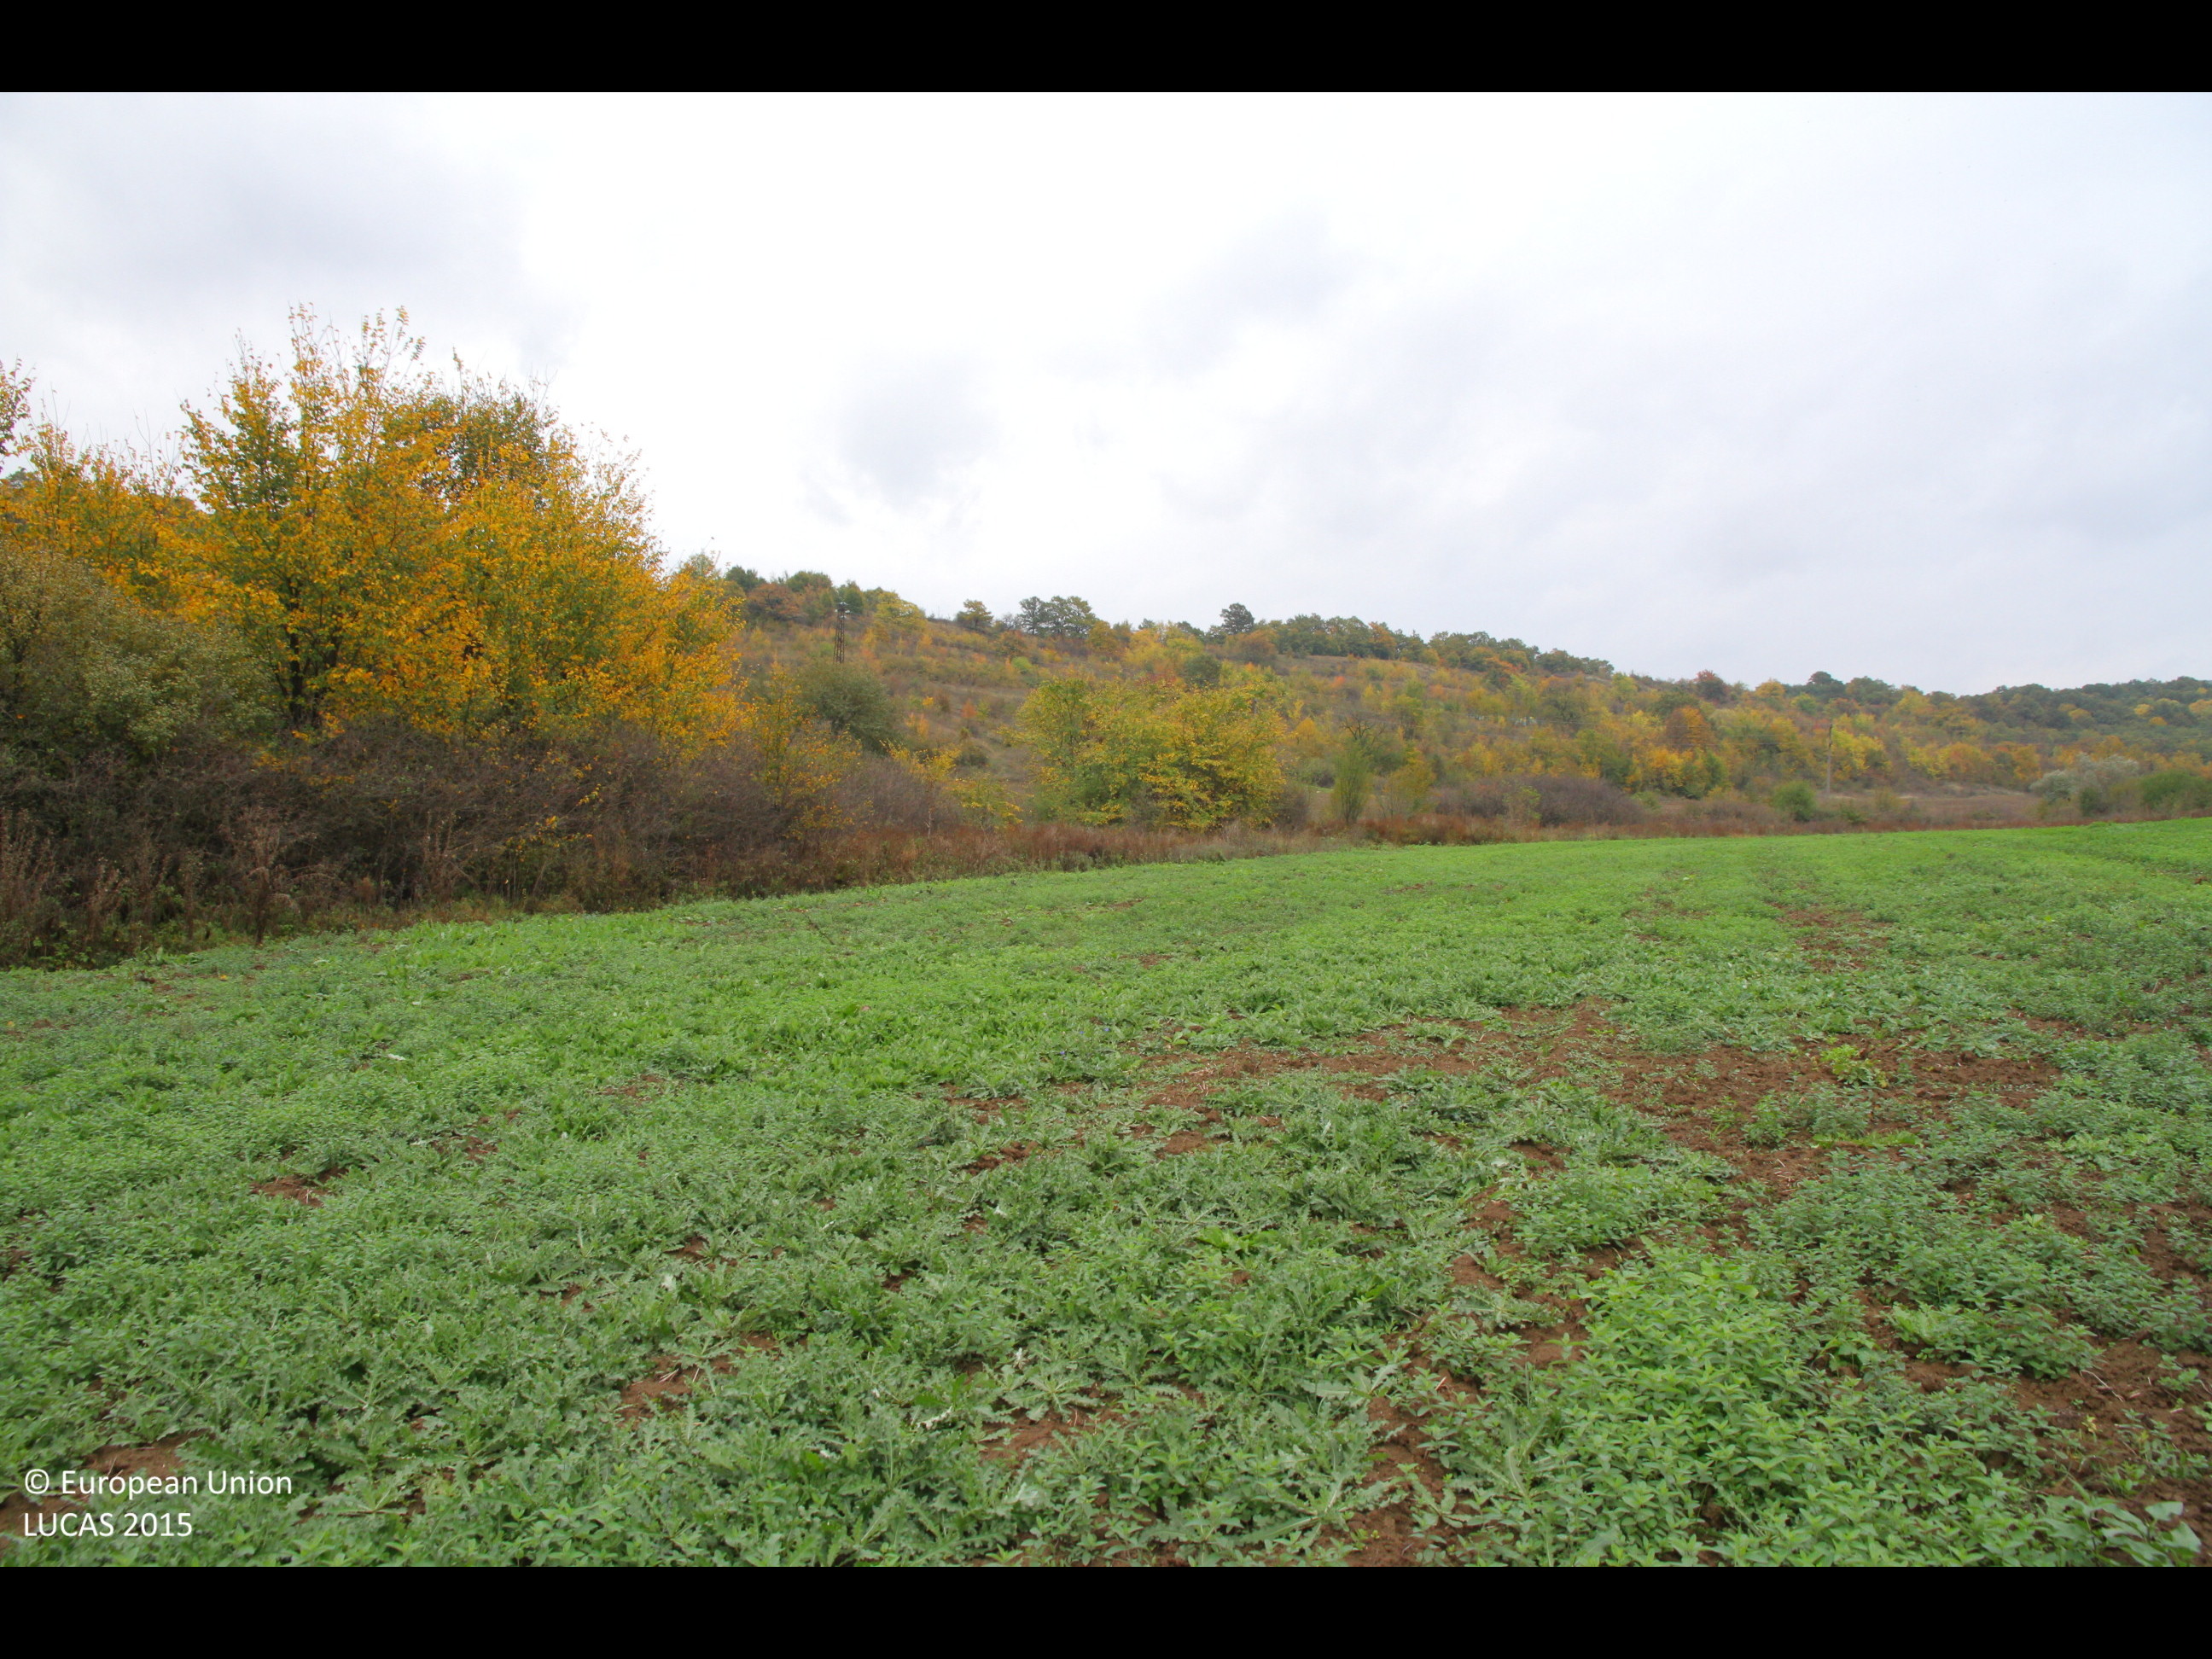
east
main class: Grassland
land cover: Spontaneously vegetated surfaces
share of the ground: > 75 %
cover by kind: herbaceous plants 100 %
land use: Agriculture (excluding fallow land and kitchen gardens)
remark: Harvested field
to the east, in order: Spontaneously vegetated surfaces; Ditches and canals; Shrubland with sparse tree cover; Sunflower; Shrubland with sparse tree cover; Electric lines; Shrubland with sparse tree cover
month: October
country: BG
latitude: 43.1617
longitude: 27.0756
